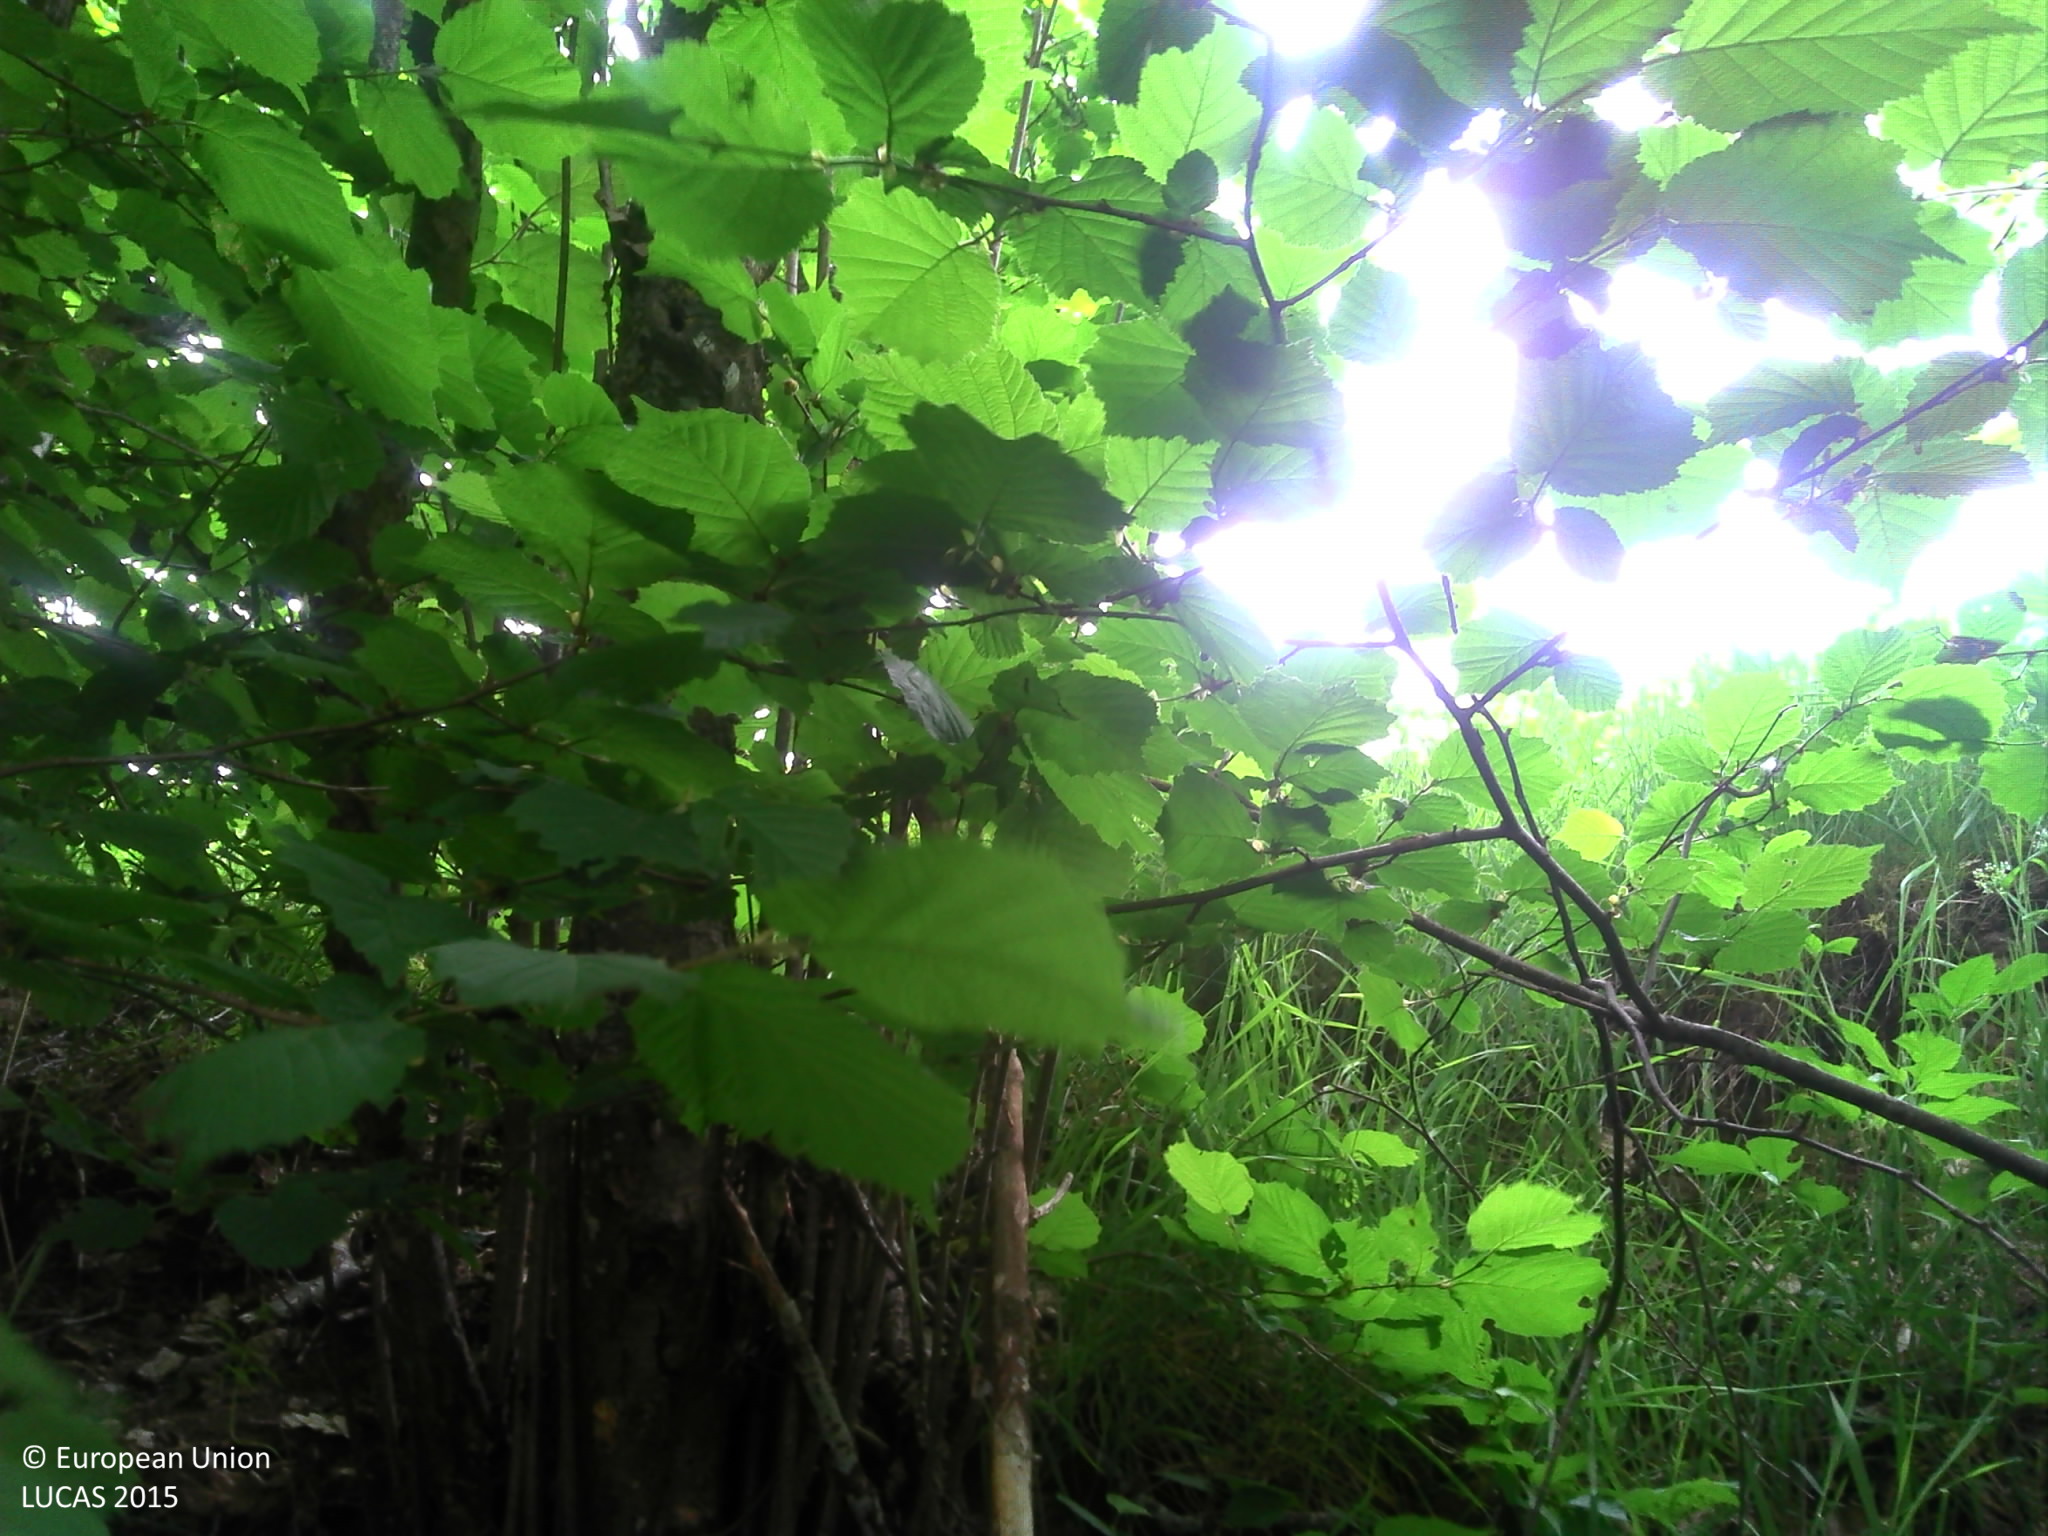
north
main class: Woodland
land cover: Broadleaved woodland
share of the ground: > 75 %
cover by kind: broadleaved forest trees 70 %, herbaceous plants 20 %, shrubs 10 %
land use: Agriculture (excluding fallow land and kitchen gardens)
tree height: > 5 m
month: June
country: FR
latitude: 45.1240
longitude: 3.2261
